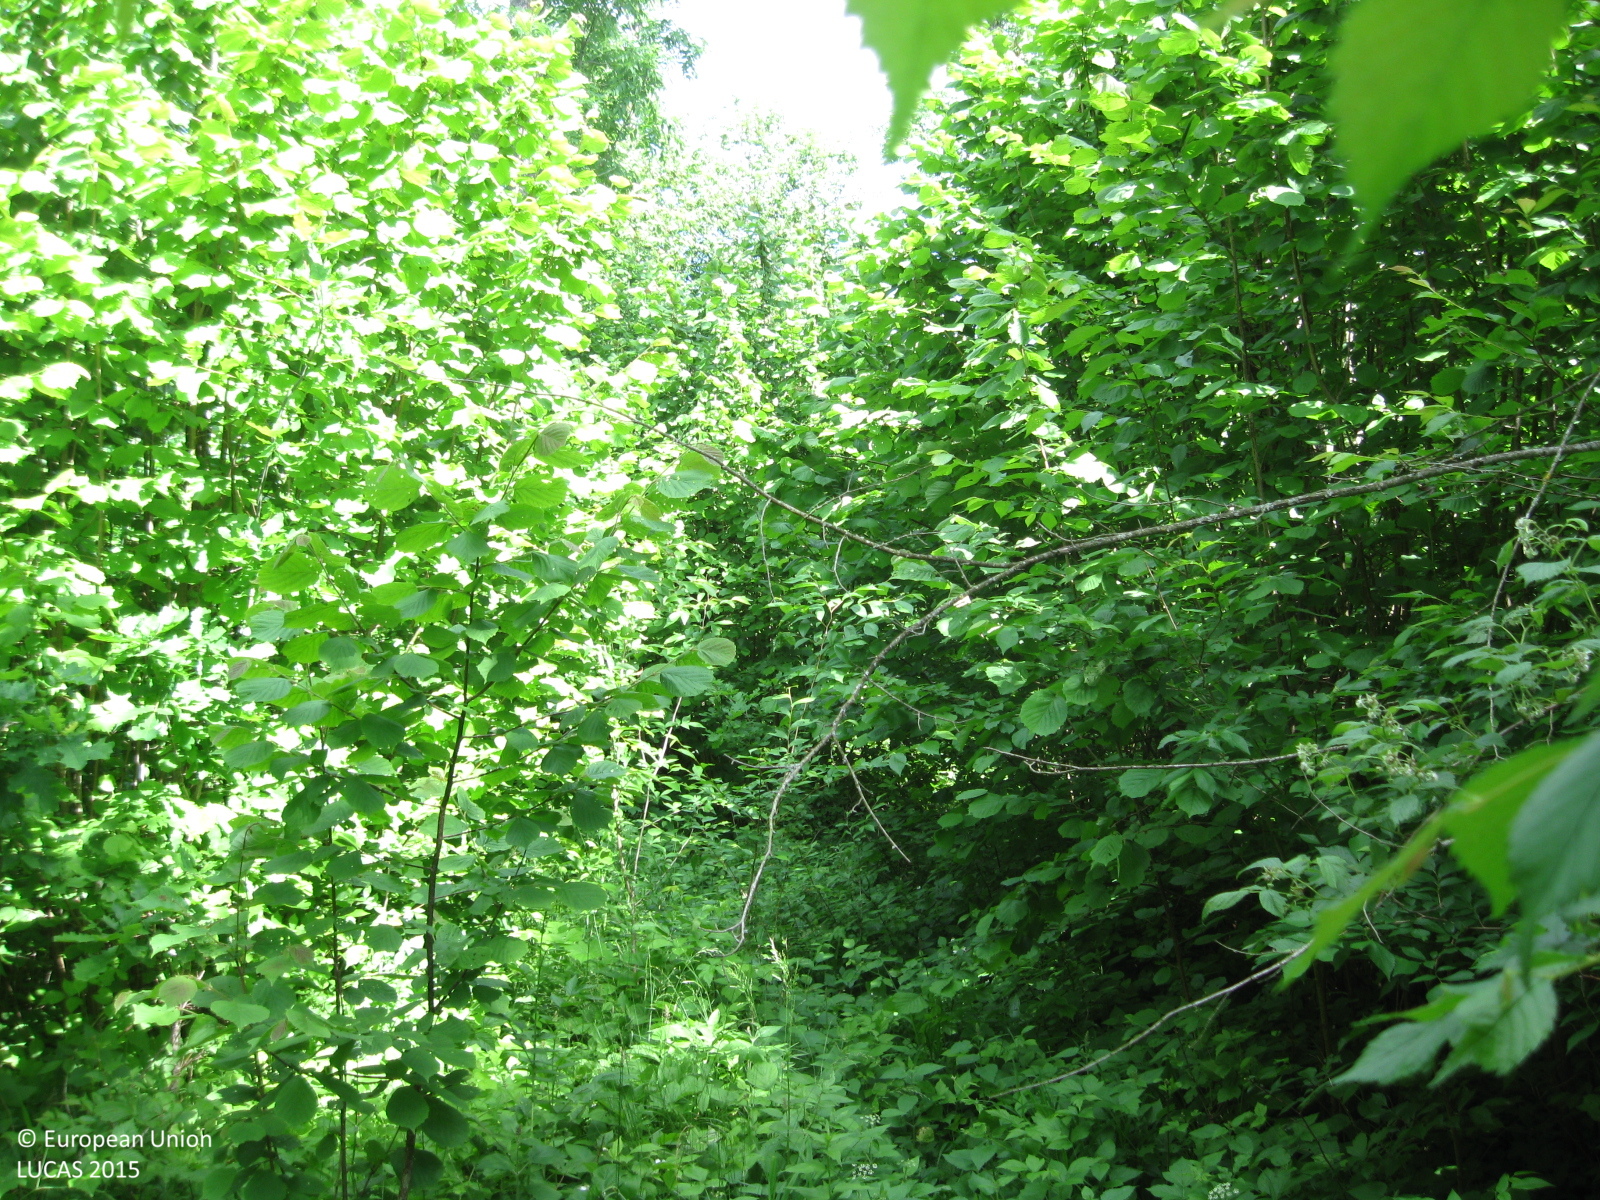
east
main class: Woodland
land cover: Broadleaved woodland
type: non-riverine alder, birch or aspen forest
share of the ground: 50 - 75 %
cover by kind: broadleaved forest trees 70 %, shrubs 15 %, herbaceous plants 15 %
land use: Forestry
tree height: > 5 m
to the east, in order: Broadleaved woodland; Tracks; Grassland with sparse tree/shrub cover; Ditches and canals; Grassland without tree/shrub cover; Common wheat
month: June
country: LT
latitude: 55.3788
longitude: 23.8324
